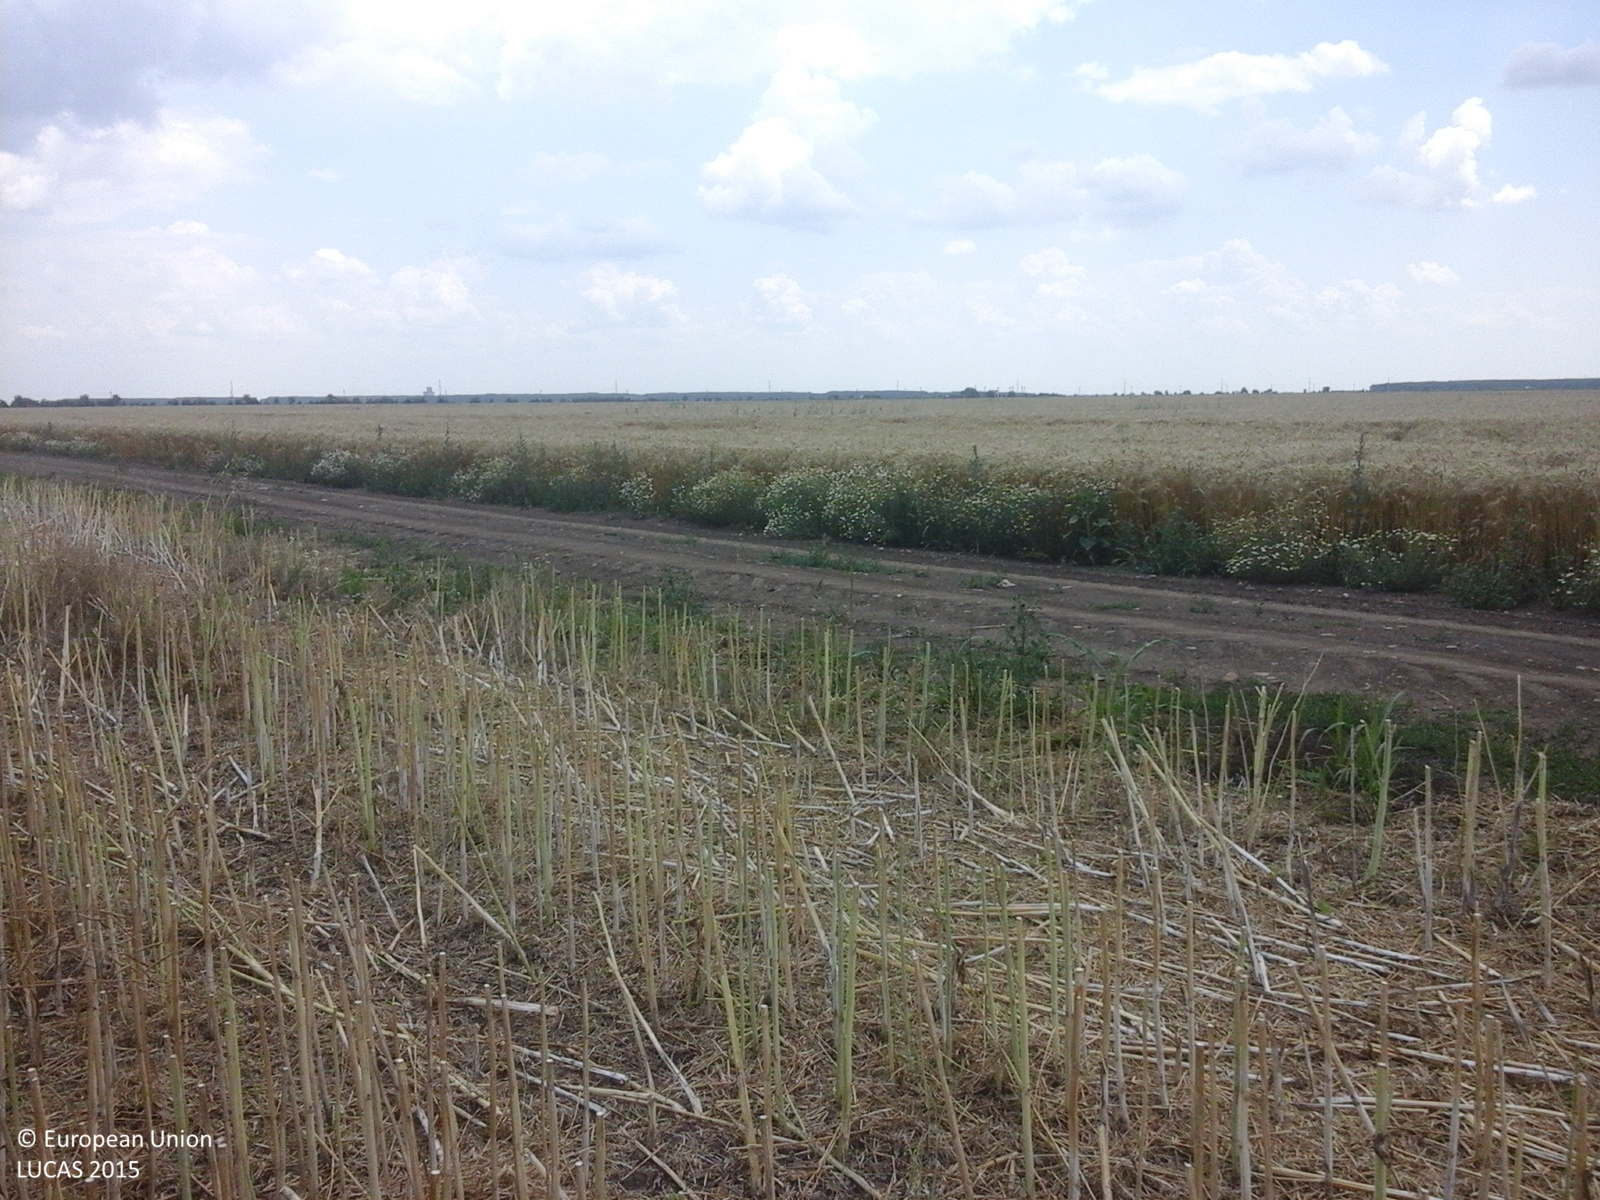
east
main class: Cropland
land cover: Rape and turnip rape
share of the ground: > 75 %
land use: Agriculture (excluding fallow land and kitchen gardens)
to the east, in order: Rape and turnip rape
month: July
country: RO
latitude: 44.0772
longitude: 25.9693
